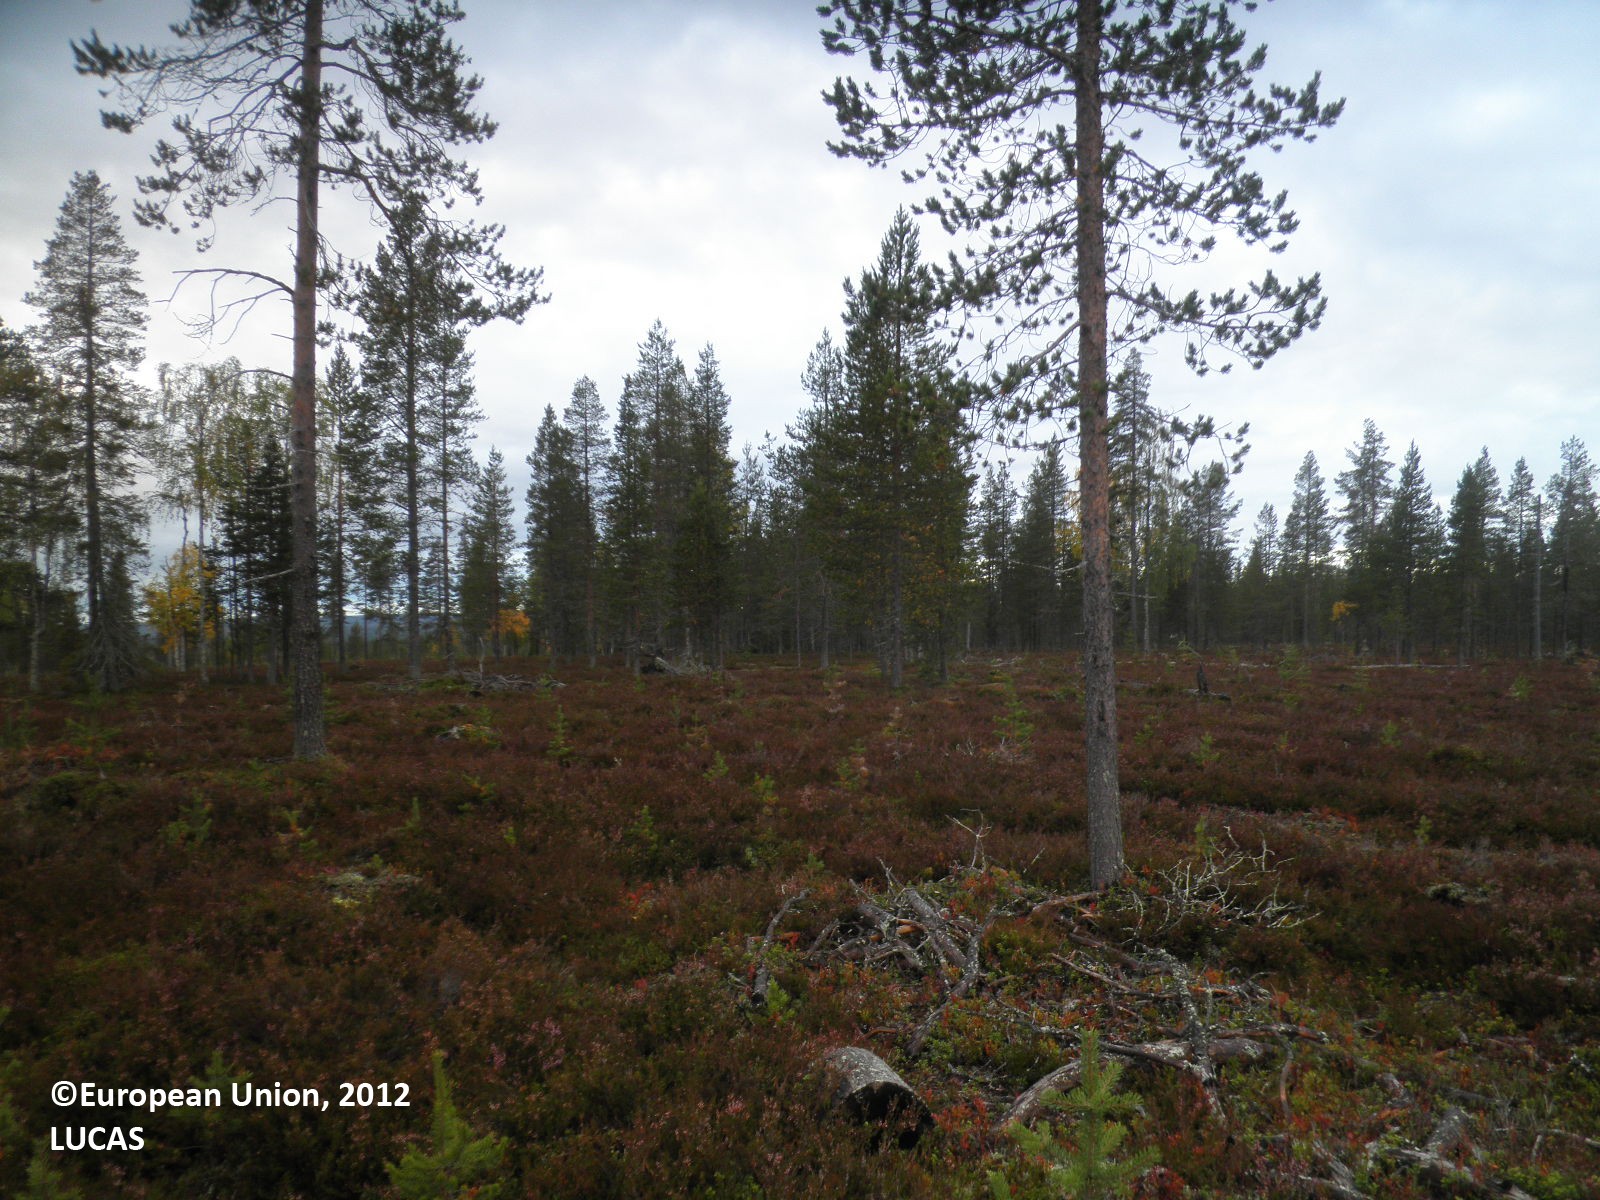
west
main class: Shrubland
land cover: Shrubland with sparse tree cover
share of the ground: > 75 %
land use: Forestry
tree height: > 5 m
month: September
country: FI
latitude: 67.7145
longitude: 28.4846
